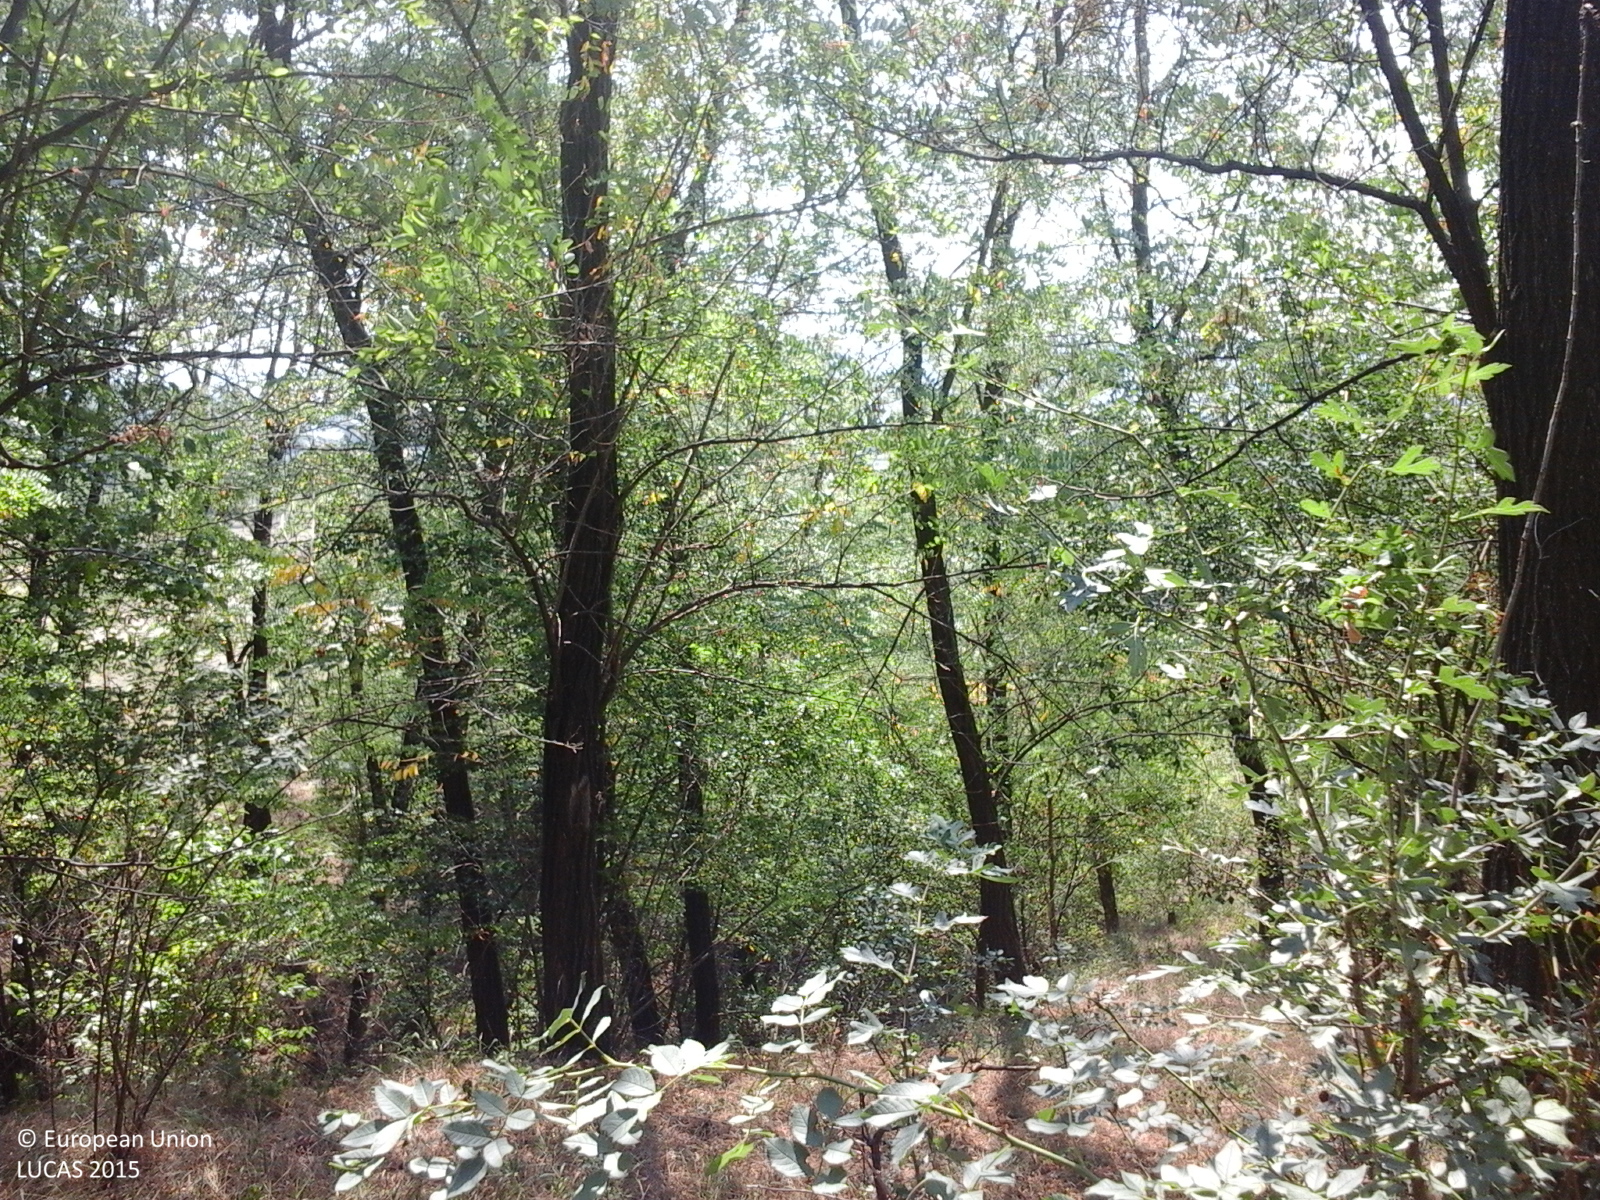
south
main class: Woodland
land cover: Broadleaved woodland
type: exotic forest
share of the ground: > 75 %
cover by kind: broadleaved forest trees 100 %
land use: Forestry
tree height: > 5 m
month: August
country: RO
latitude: 46.1436
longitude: 27.0673
